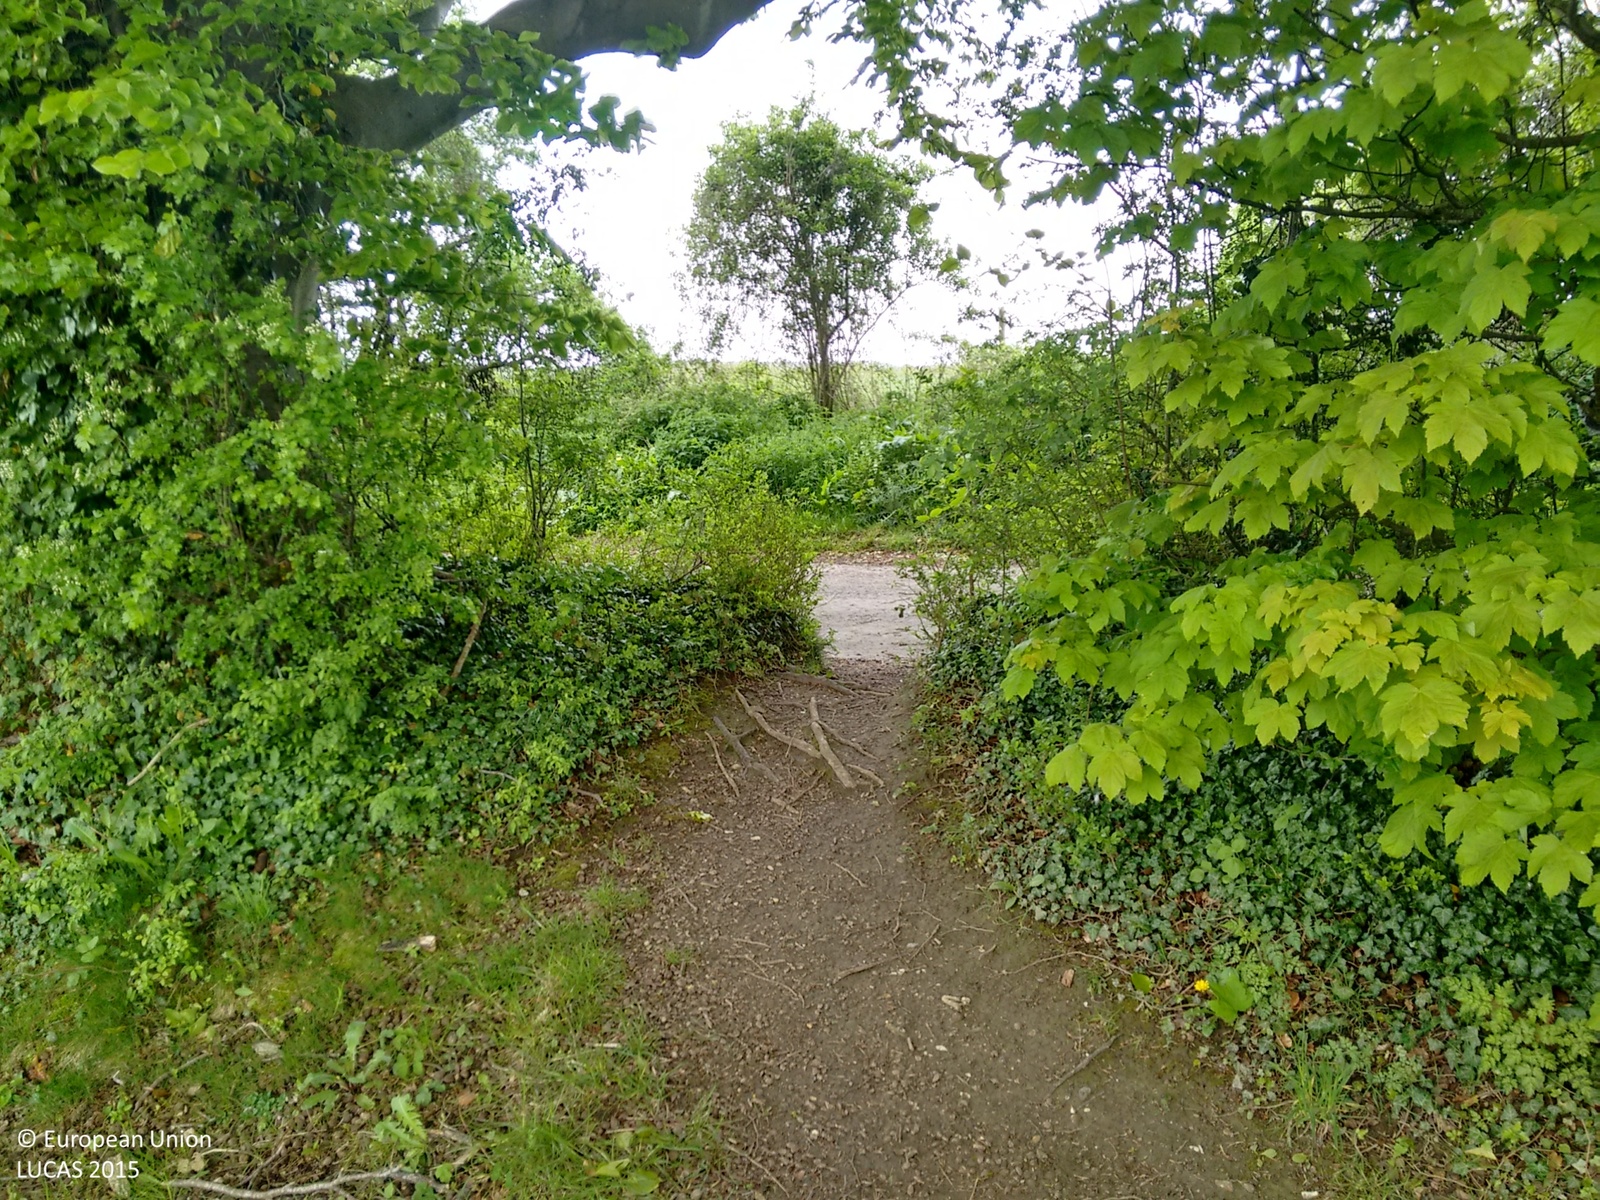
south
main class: Woodland
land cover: Broadleaved woodland
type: mesophytic deciduous forest
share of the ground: > 75 %
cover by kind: broadleaved forest trees 100 %
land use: Forestry
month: May
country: GB
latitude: 51.2030
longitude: -1.4575
